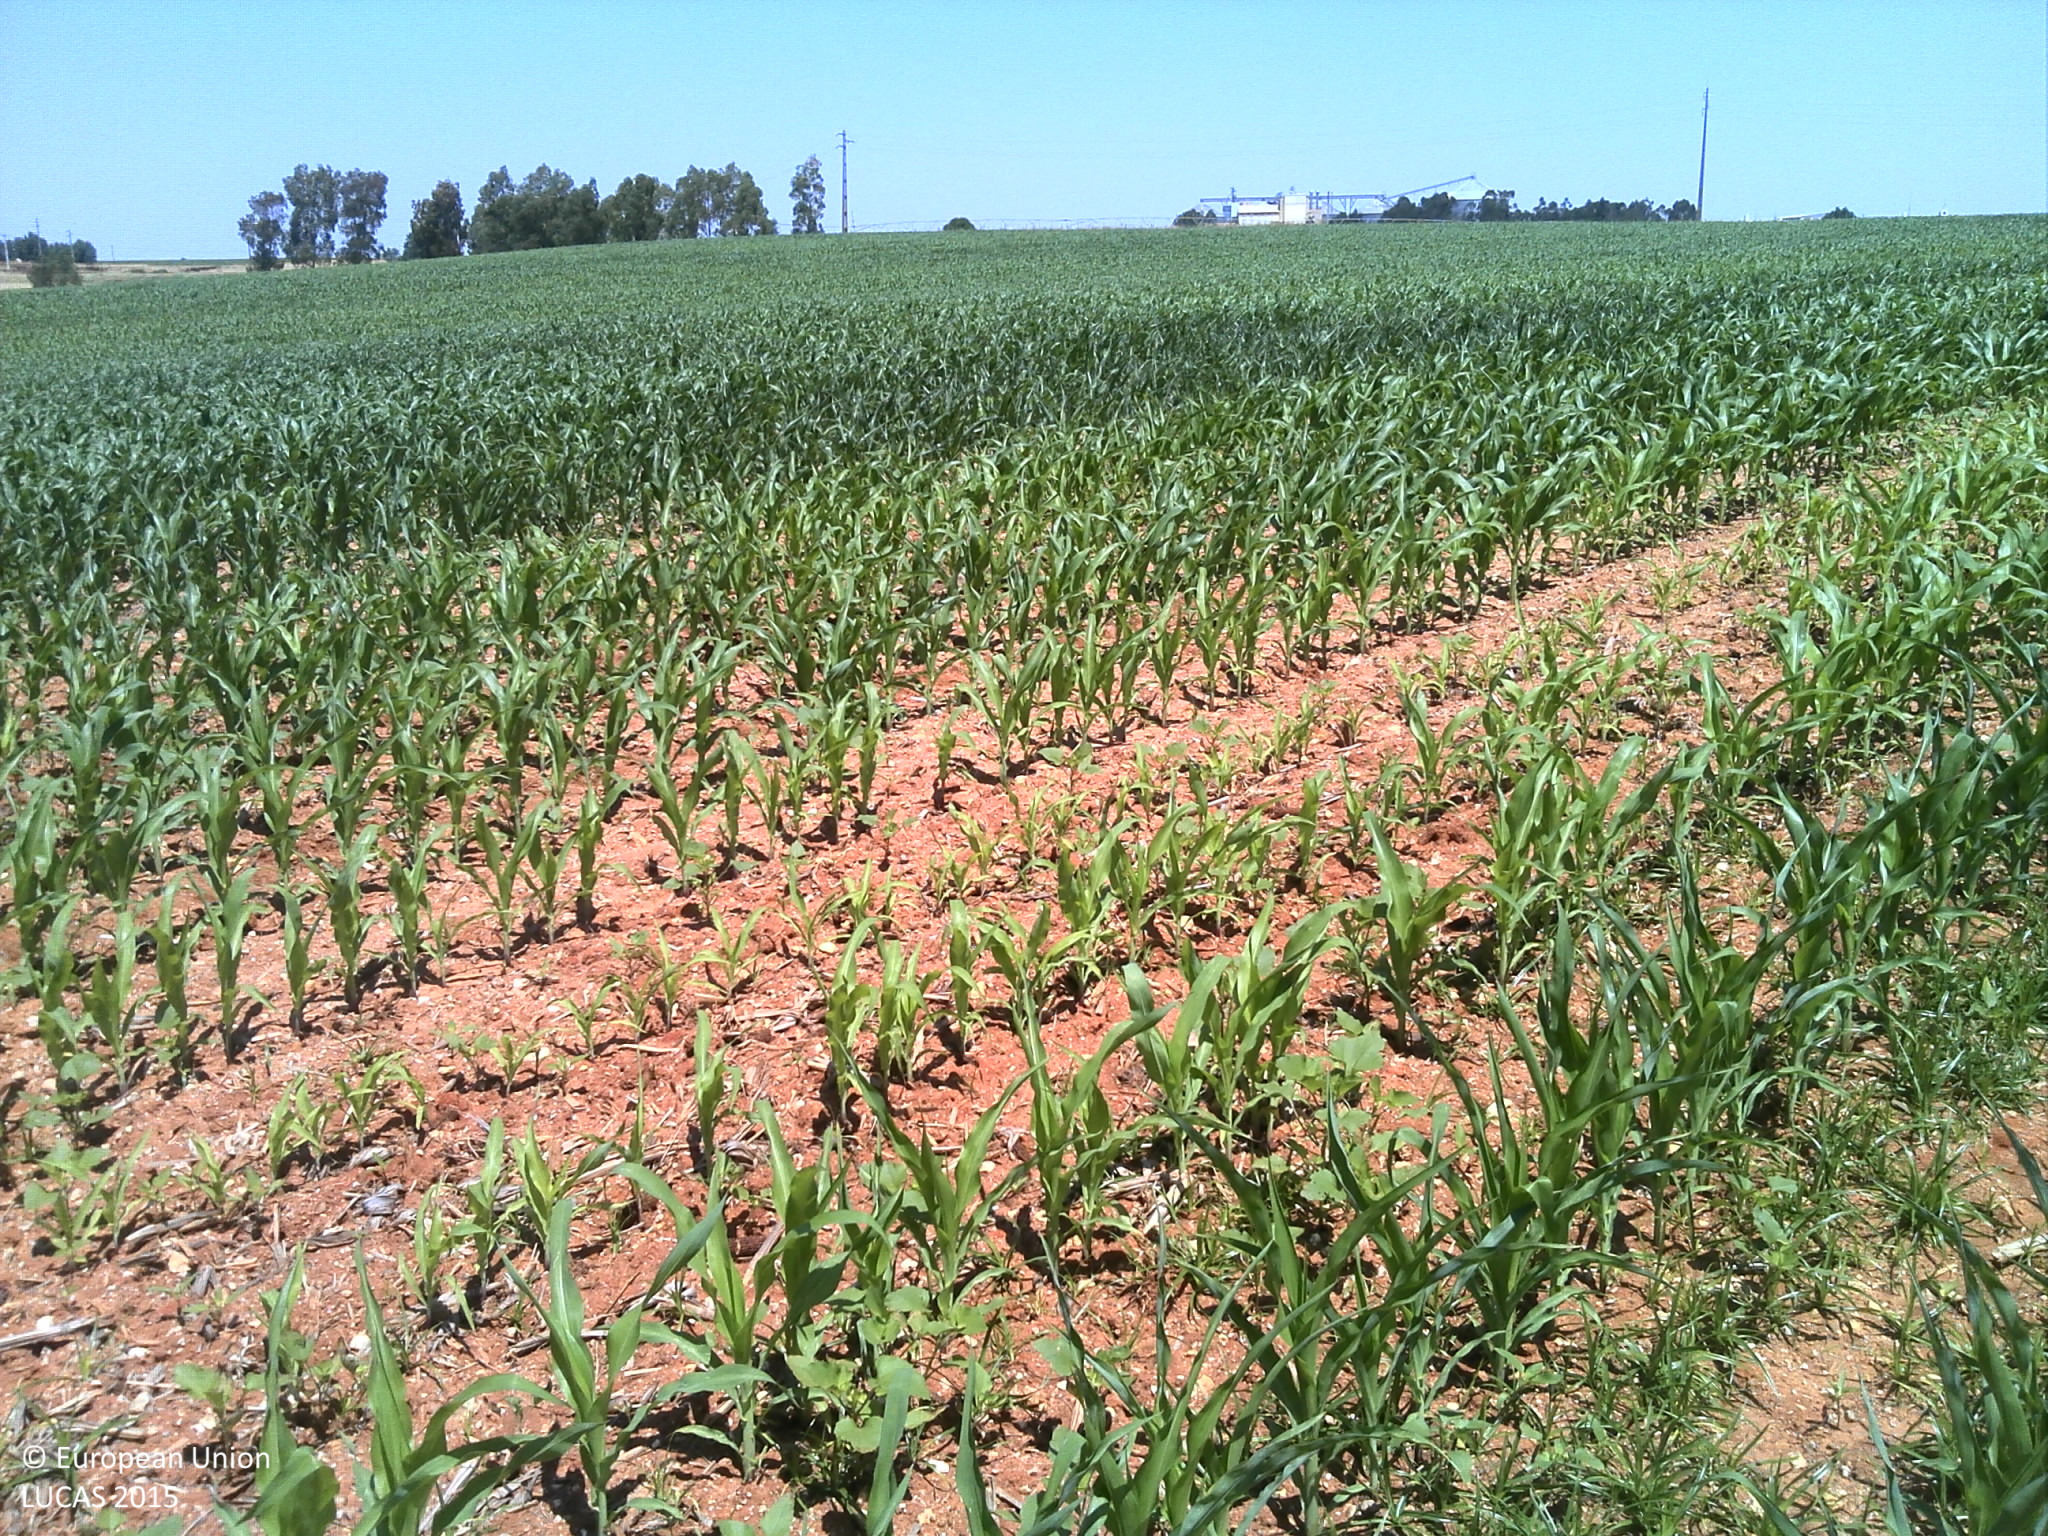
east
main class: Cropland
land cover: Maize
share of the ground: 10 - 25 %
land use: Agriculture (excluding fallow land and kitchen gardens)
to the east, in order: Maize; Grass margins; Tracks; Grass margins; Fences; Electric lines; Grass margins; Ditches and canals; Grass margins; Fences; Grass margins; Maize
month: June
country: PT
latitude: 37.9113
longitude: -8.3382
